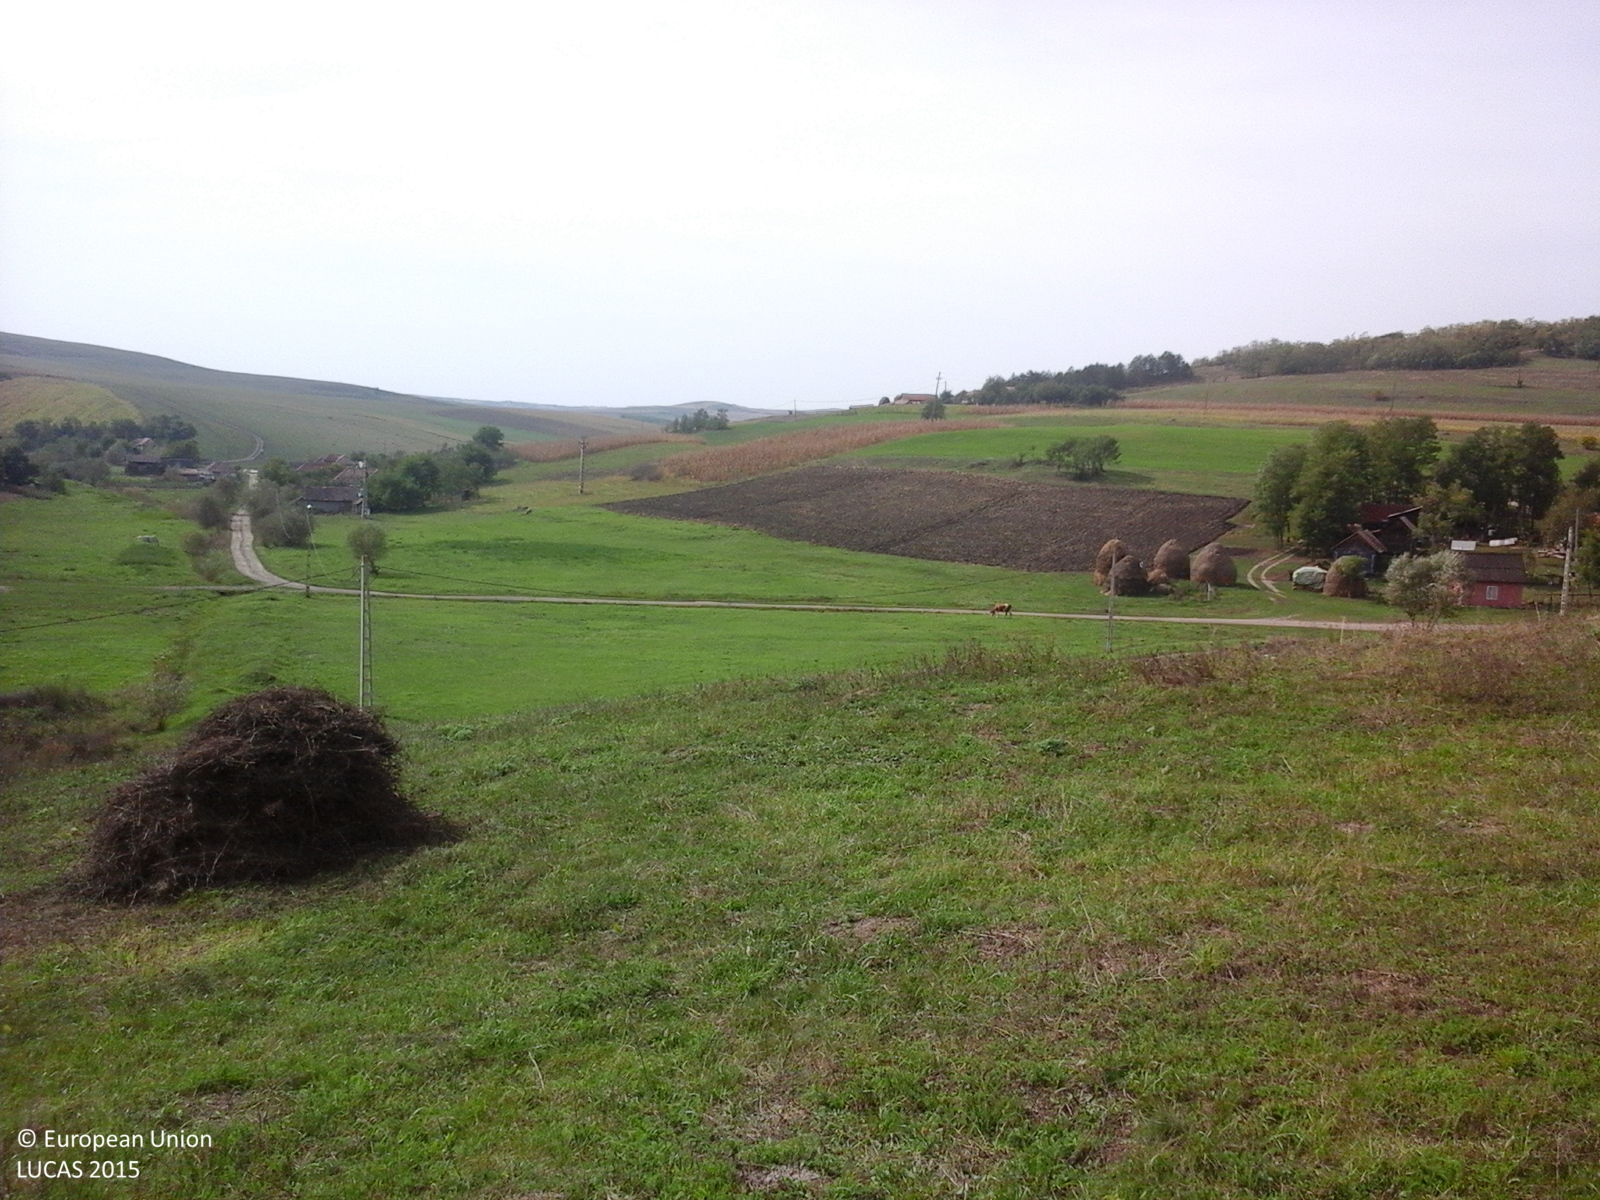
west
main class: Grassland
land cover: Grassland without tree/shrub cover
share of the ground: > 75 %
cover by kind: herbaceous plants 100 %
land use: Agriculture (excluding fallow land and kitchen gardens)
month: September
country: RO
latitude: 46.8268
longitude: 24.1745
